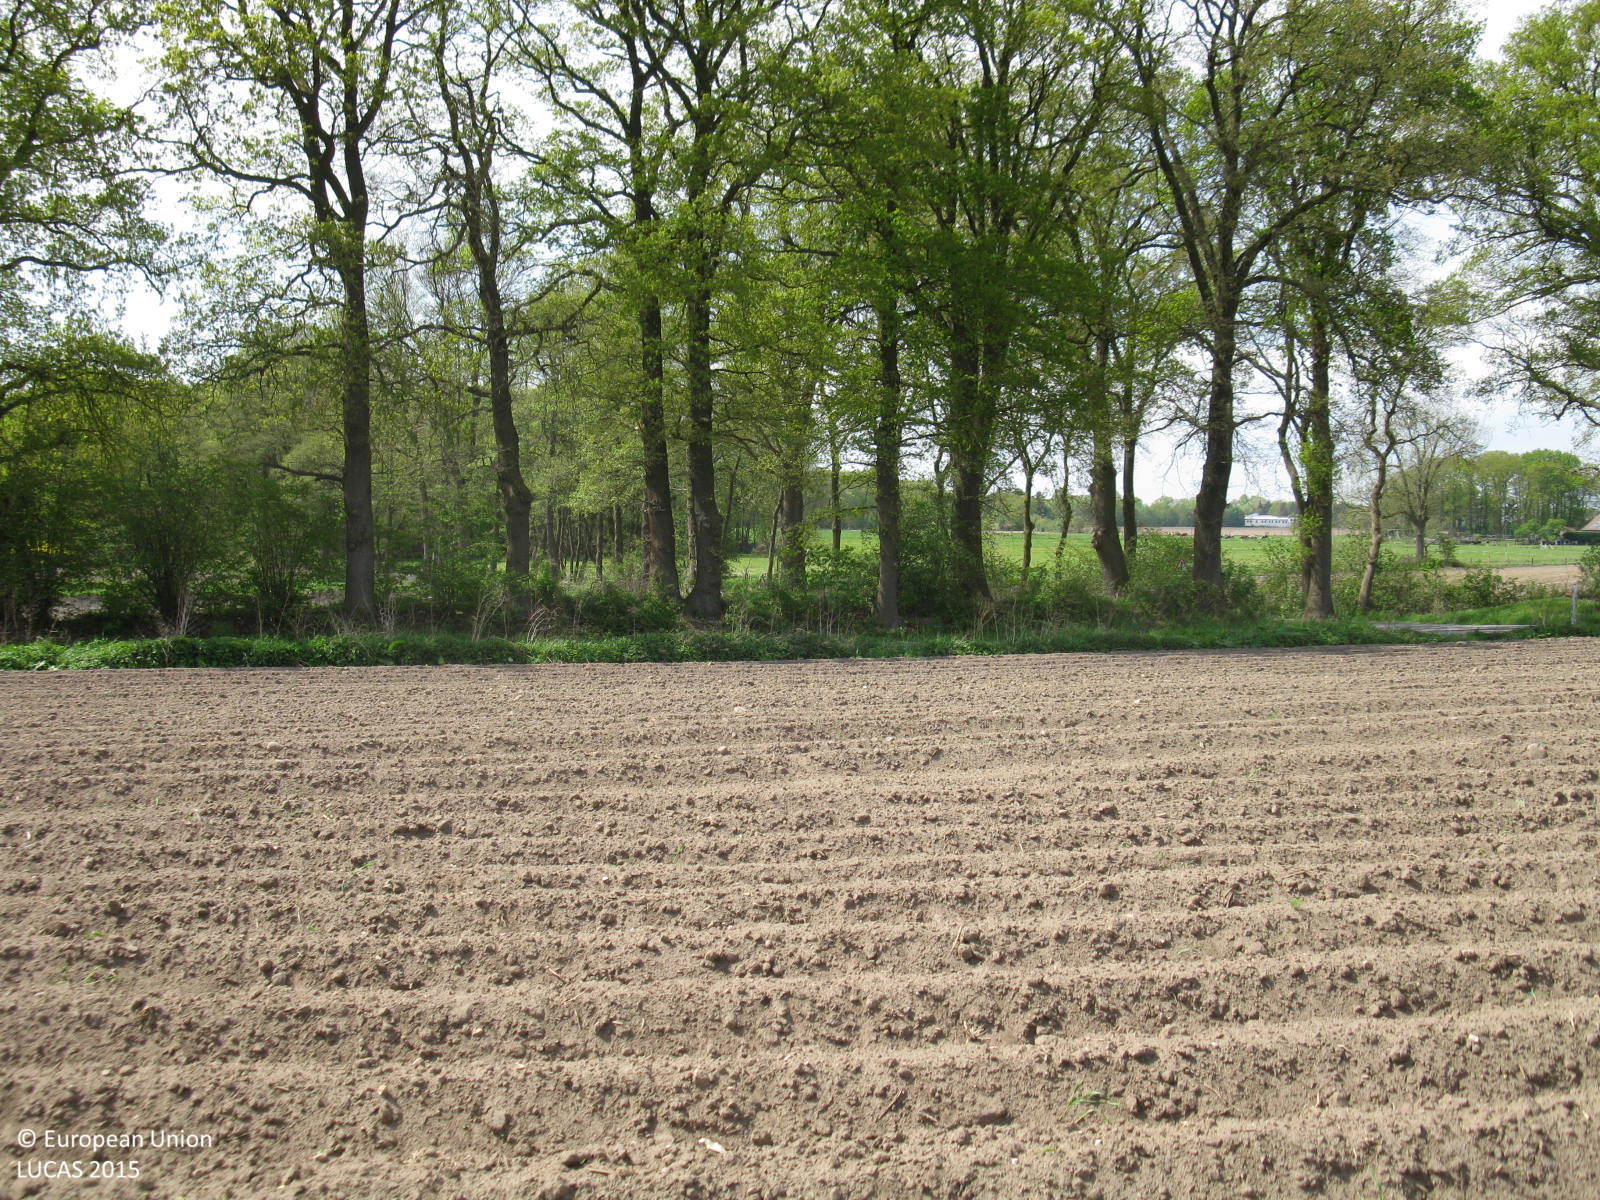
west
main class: Cropland
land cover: Potatoes
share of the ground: < 10 %
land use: Agriculture (excluding fallow land and kitchen gardens)
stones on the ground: < 10 %
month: May
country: DE
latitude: 52.8091
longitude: 7.9385
